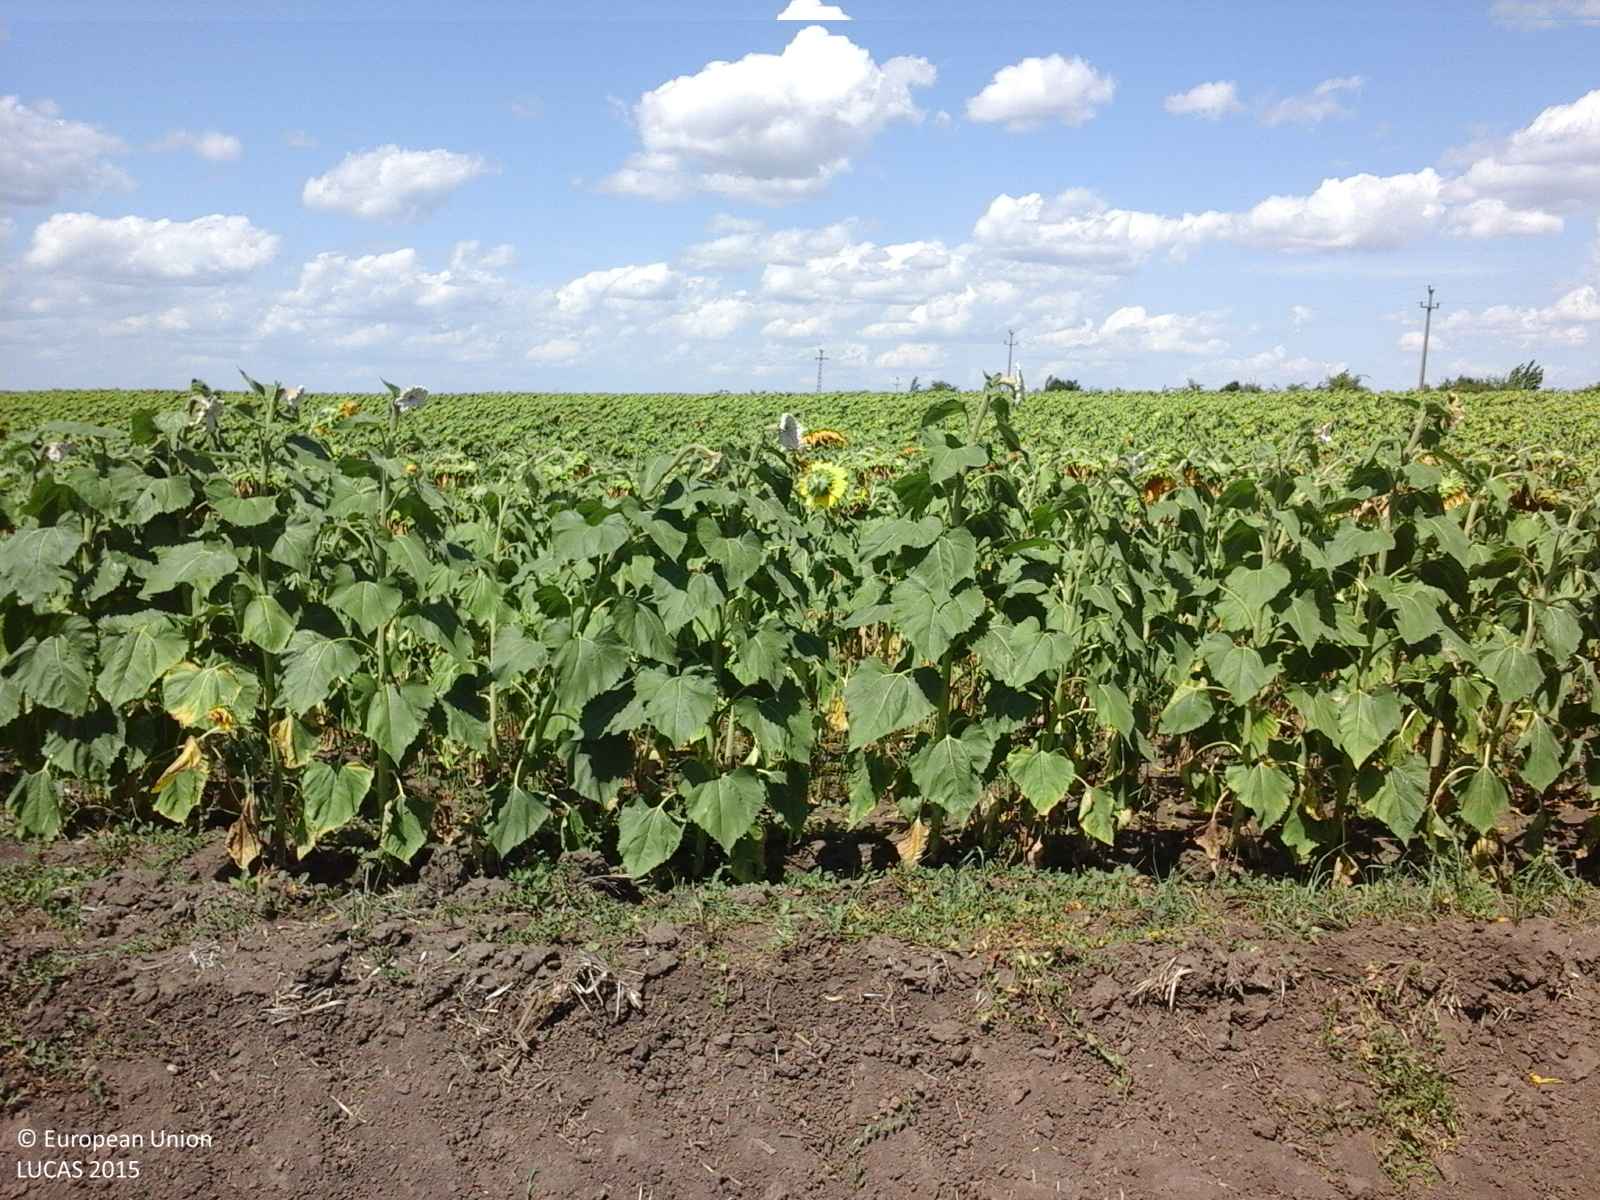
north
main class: Cropland
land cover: Sunflower
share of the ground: > 75 %
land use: Agriculture (excluding fallow land and kitchen gardens)
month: July
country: RO
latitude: 45.9565
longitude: 27.7515
